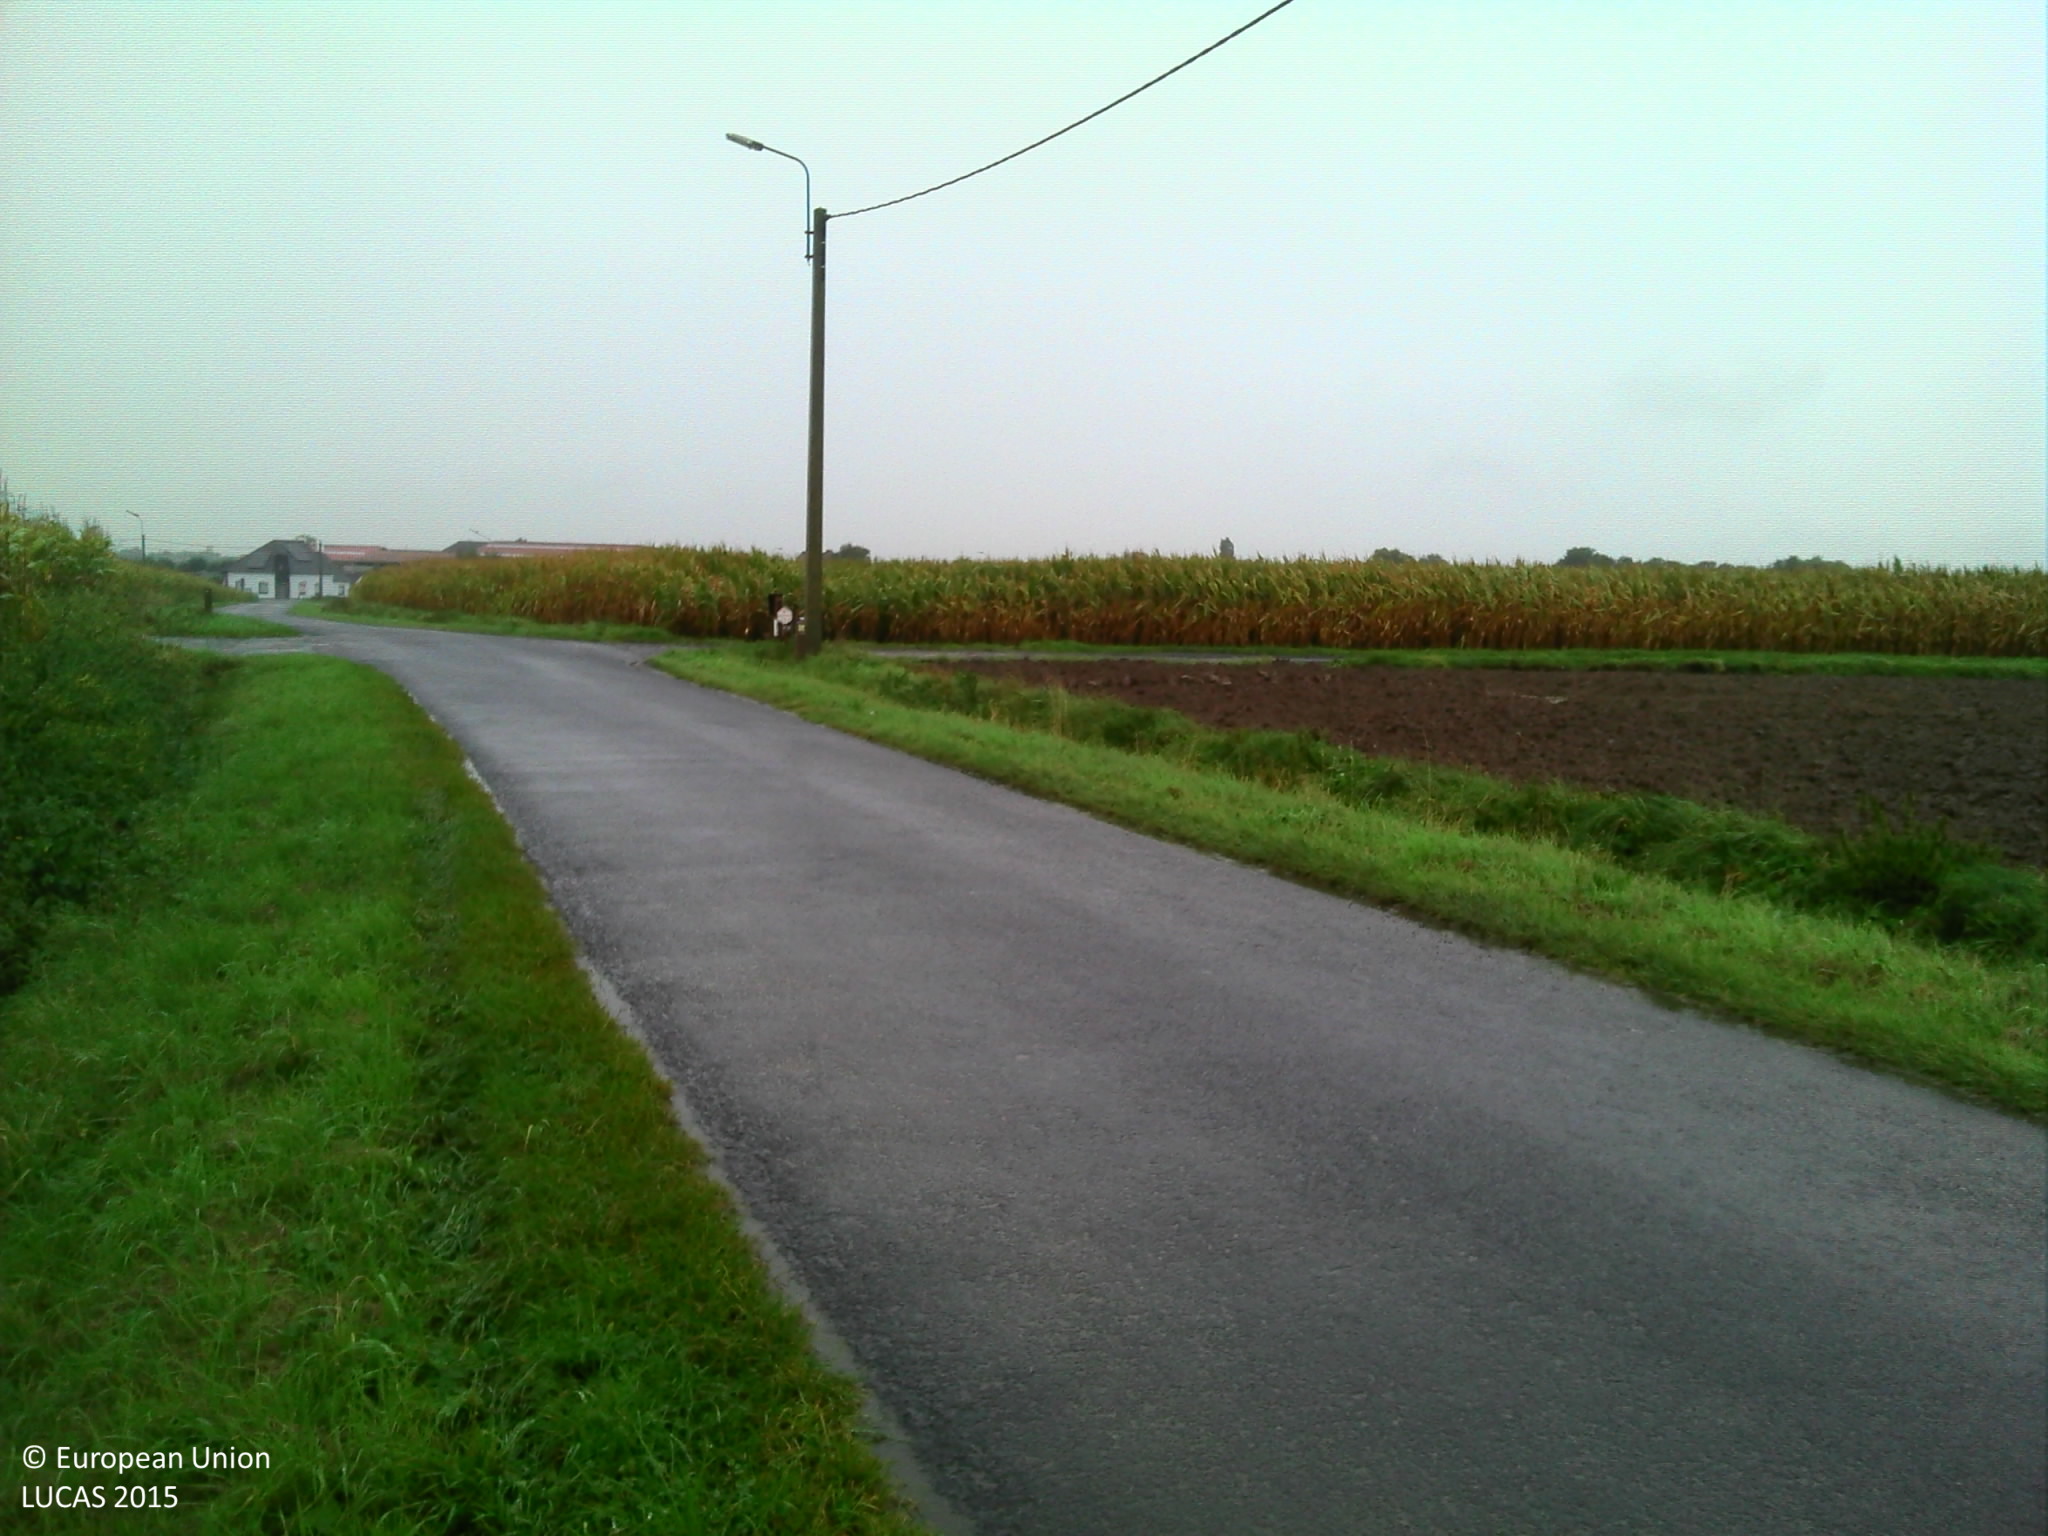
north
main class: Cropland
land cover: Maize
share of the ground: > 75 %
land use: Agriculture (excluding fallow land and kitchen gardens)
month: October
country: BE
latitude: 50.9207
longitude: 2.9195
